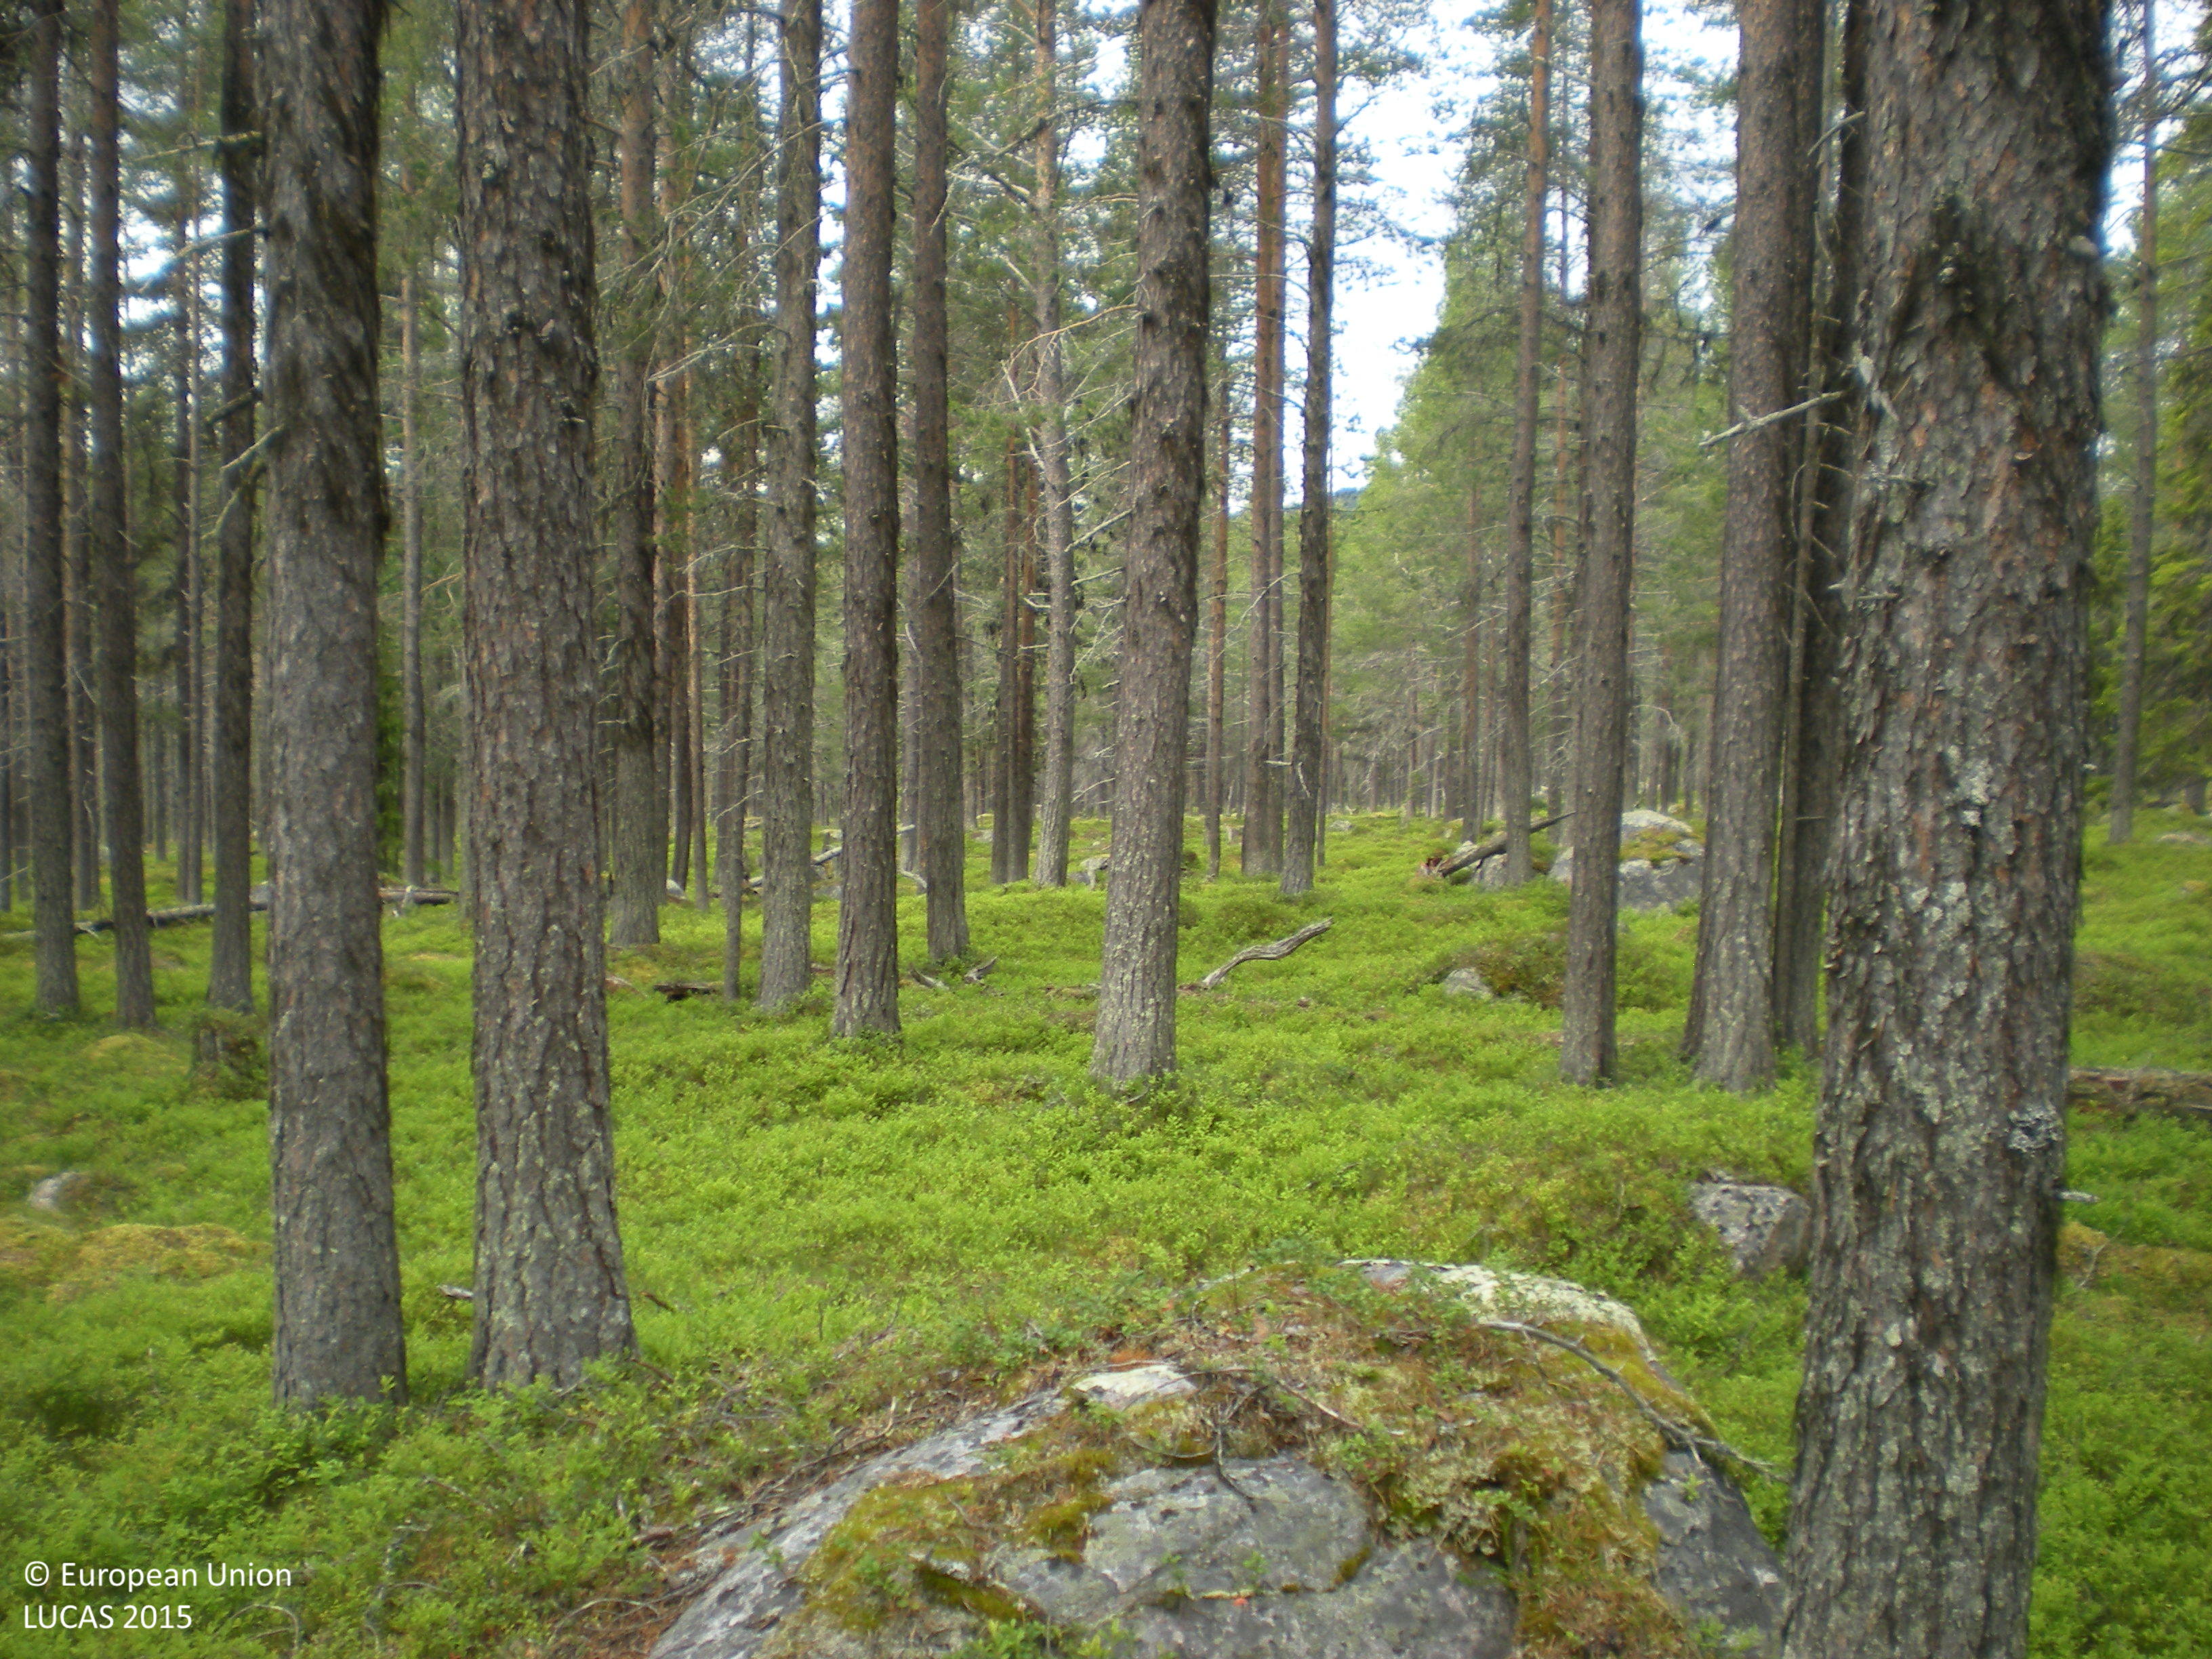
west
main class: Woodland
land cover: Pine dominated coniferous woodland
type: boreal forest
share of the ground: 50 - 75 %
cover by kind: coniferous forest trees 65 %, shrubs 25 %, lichens and mosses 5 %, consolidated bare surface 5 %
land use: Forestry
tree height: > 5 m
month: July
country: SE
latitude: 65.8042
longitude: 18.2007
